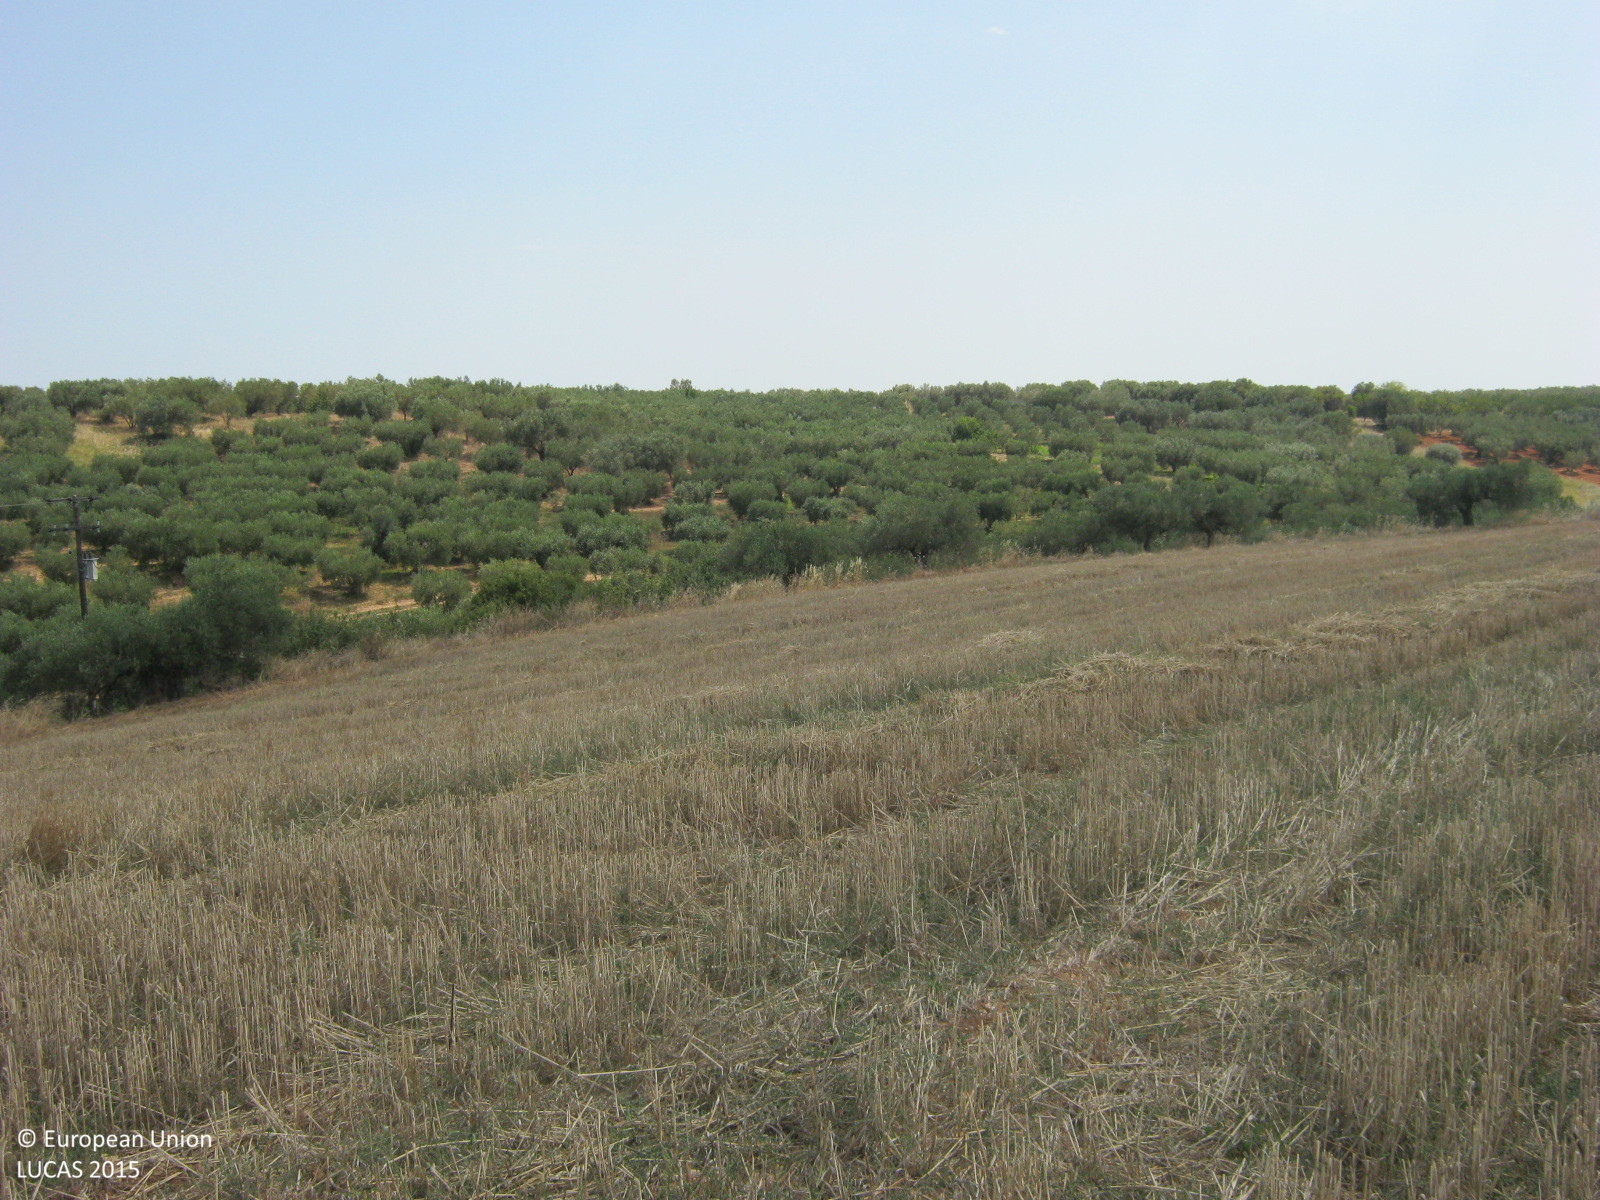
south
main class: Cropland
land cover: Common wheat
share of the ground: > 75 %
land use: Agriculture (excluding fallow land and kitchen gardens)
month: July
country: GR
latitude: 40.3429
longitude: 23.3227
